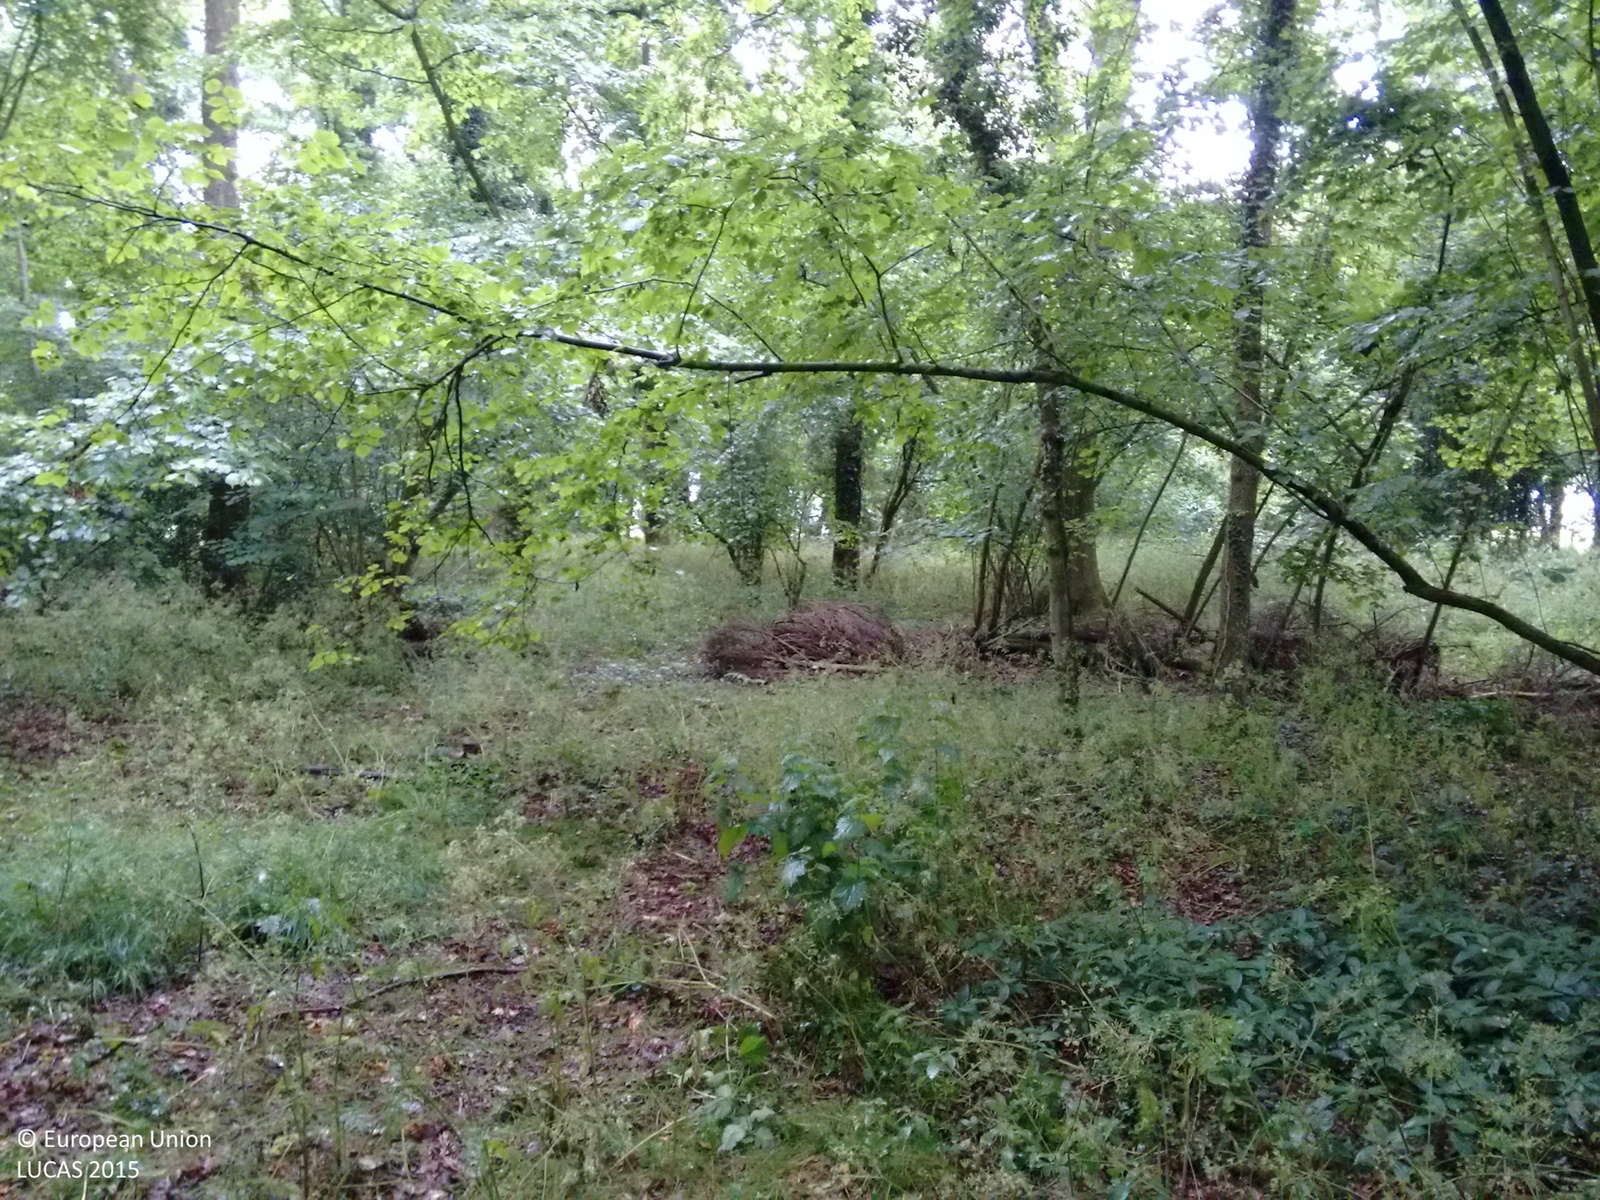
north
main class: Woodland
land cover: Broadleaved woodland
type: mesophytic deciduous forest
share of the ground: > 75 %
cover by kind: broadleaved forest trees 95 %, herbaceous plants 5 %
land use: Forestry
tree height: > 5 m
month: June
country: GB
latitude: 51.5105
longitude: -1.0973
